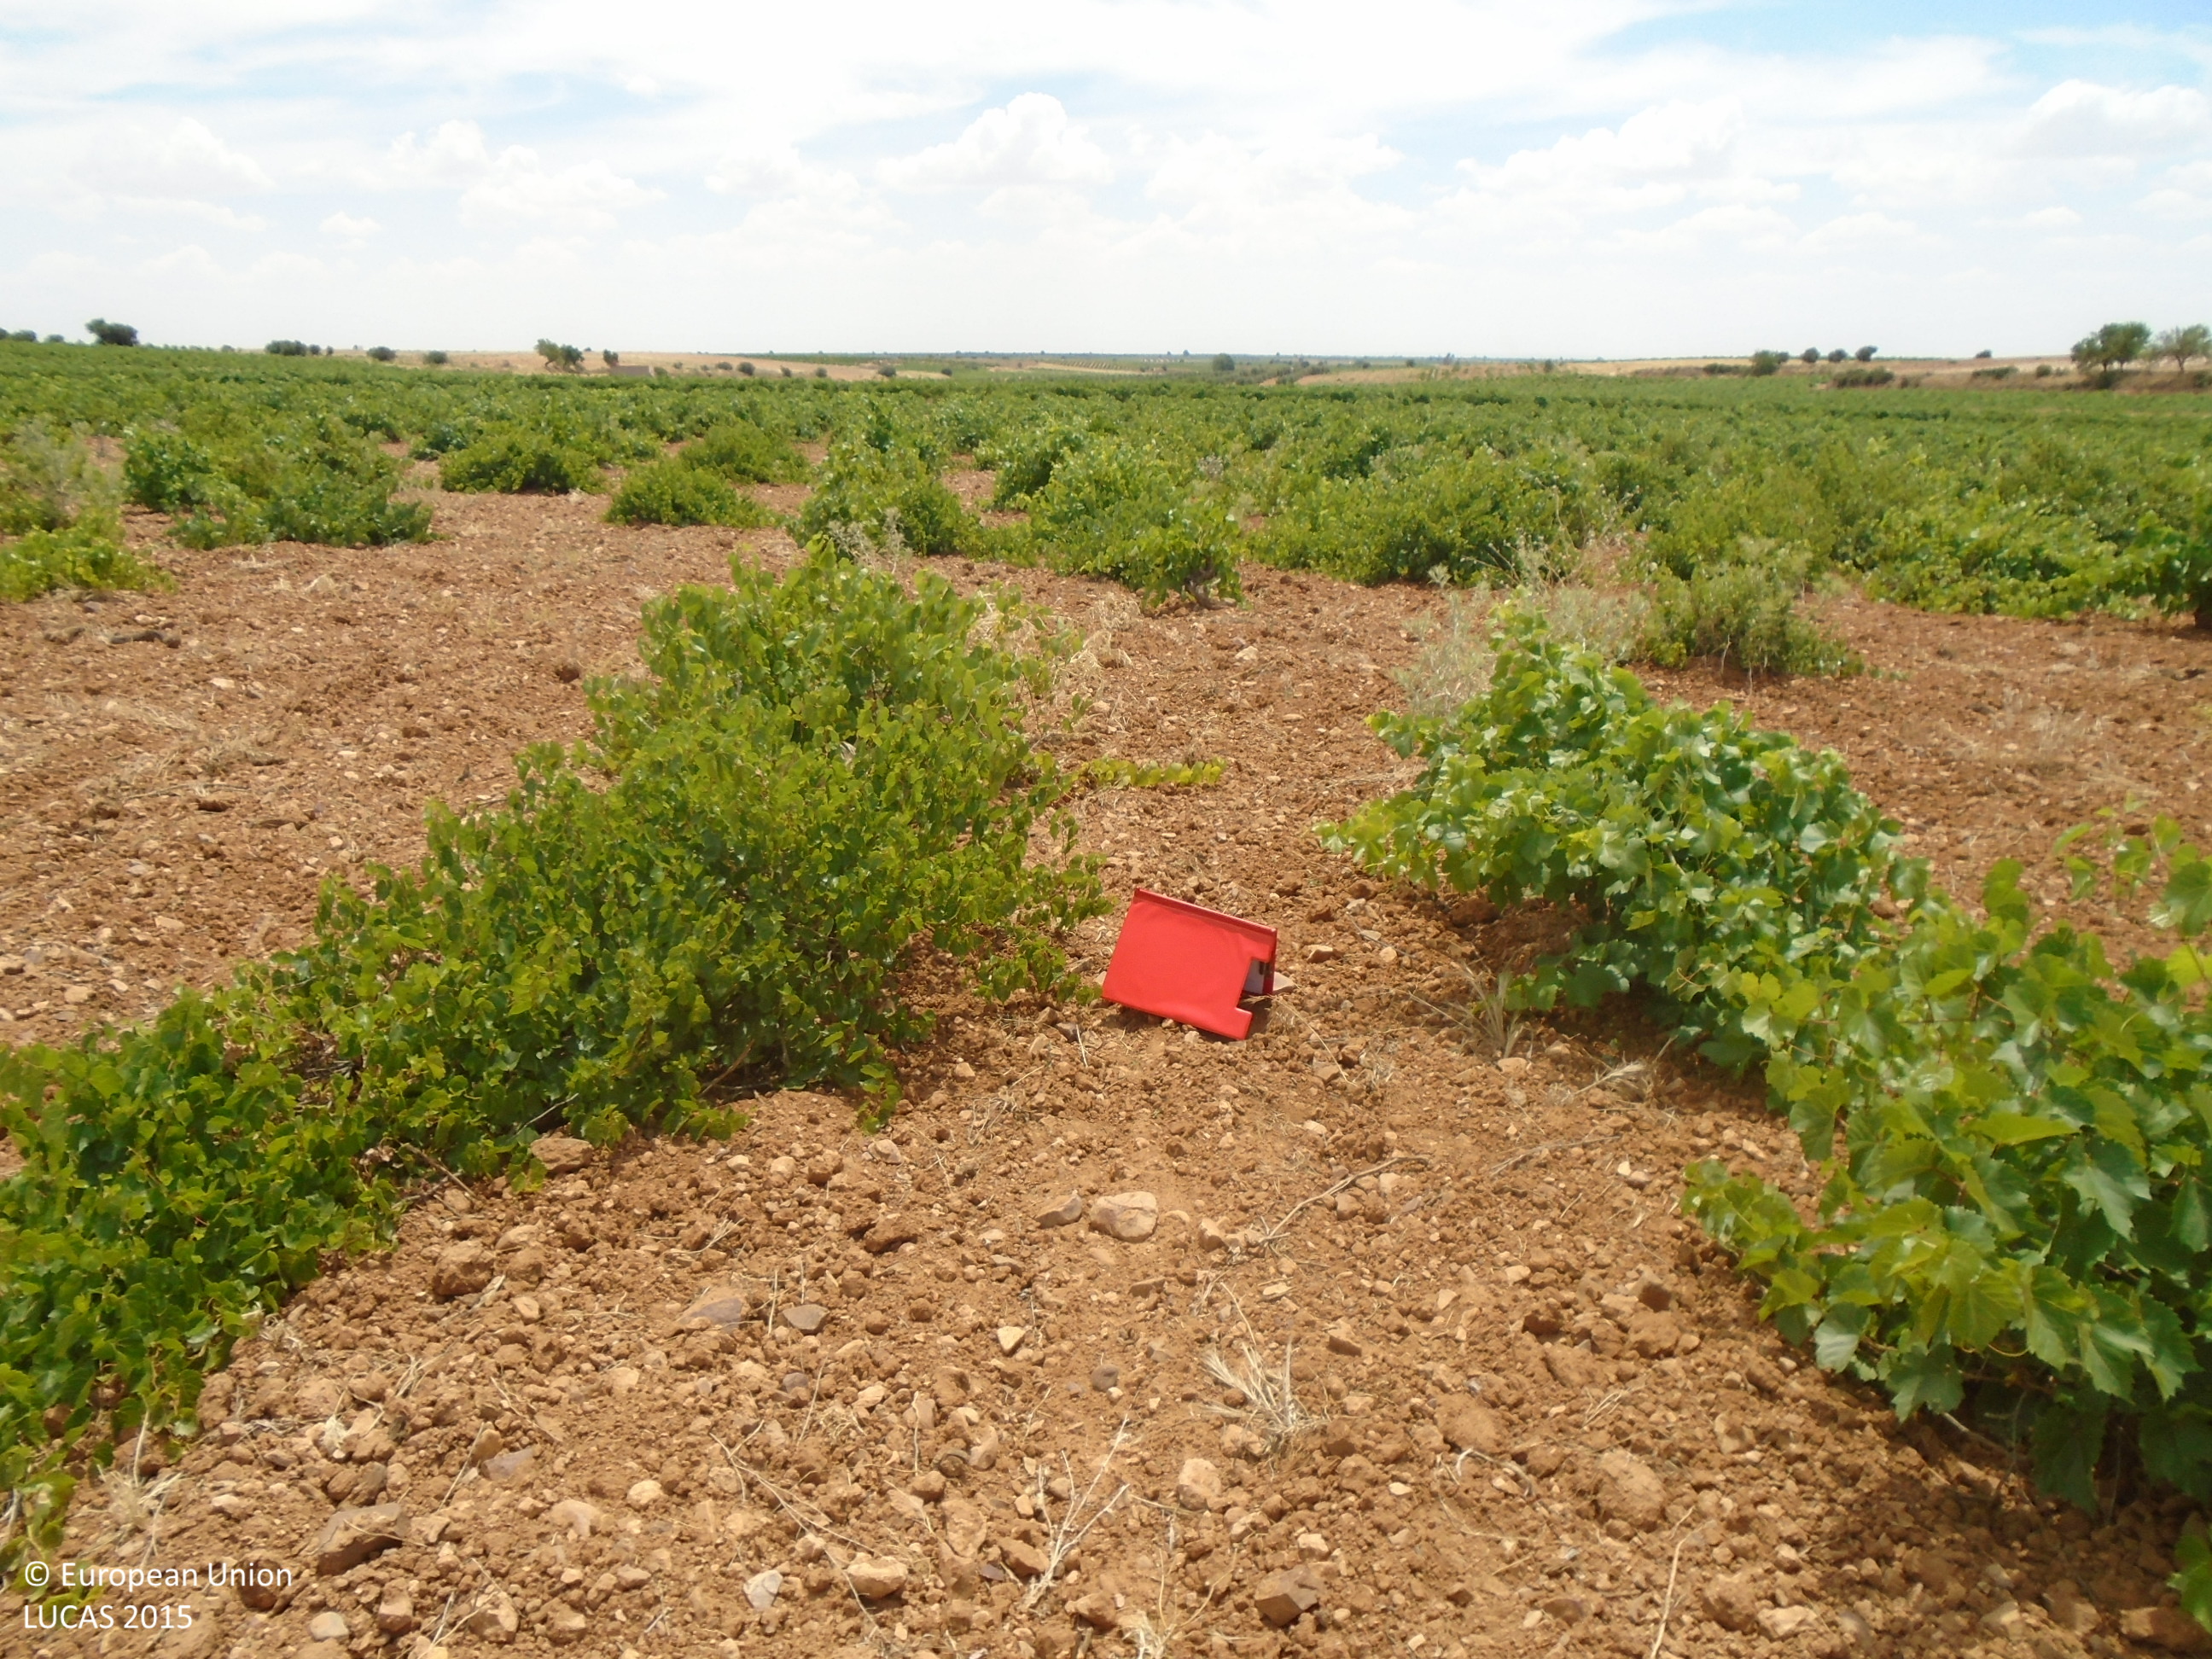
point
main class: Cropland
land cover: Vineyards
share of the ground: 25 - 50 %
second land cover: Other bare soil
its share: > 75 %
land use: Agriculture (excluding fallow land and kitchen gardens)
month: June
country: ES
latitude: 39.2261
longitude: -3.5843
